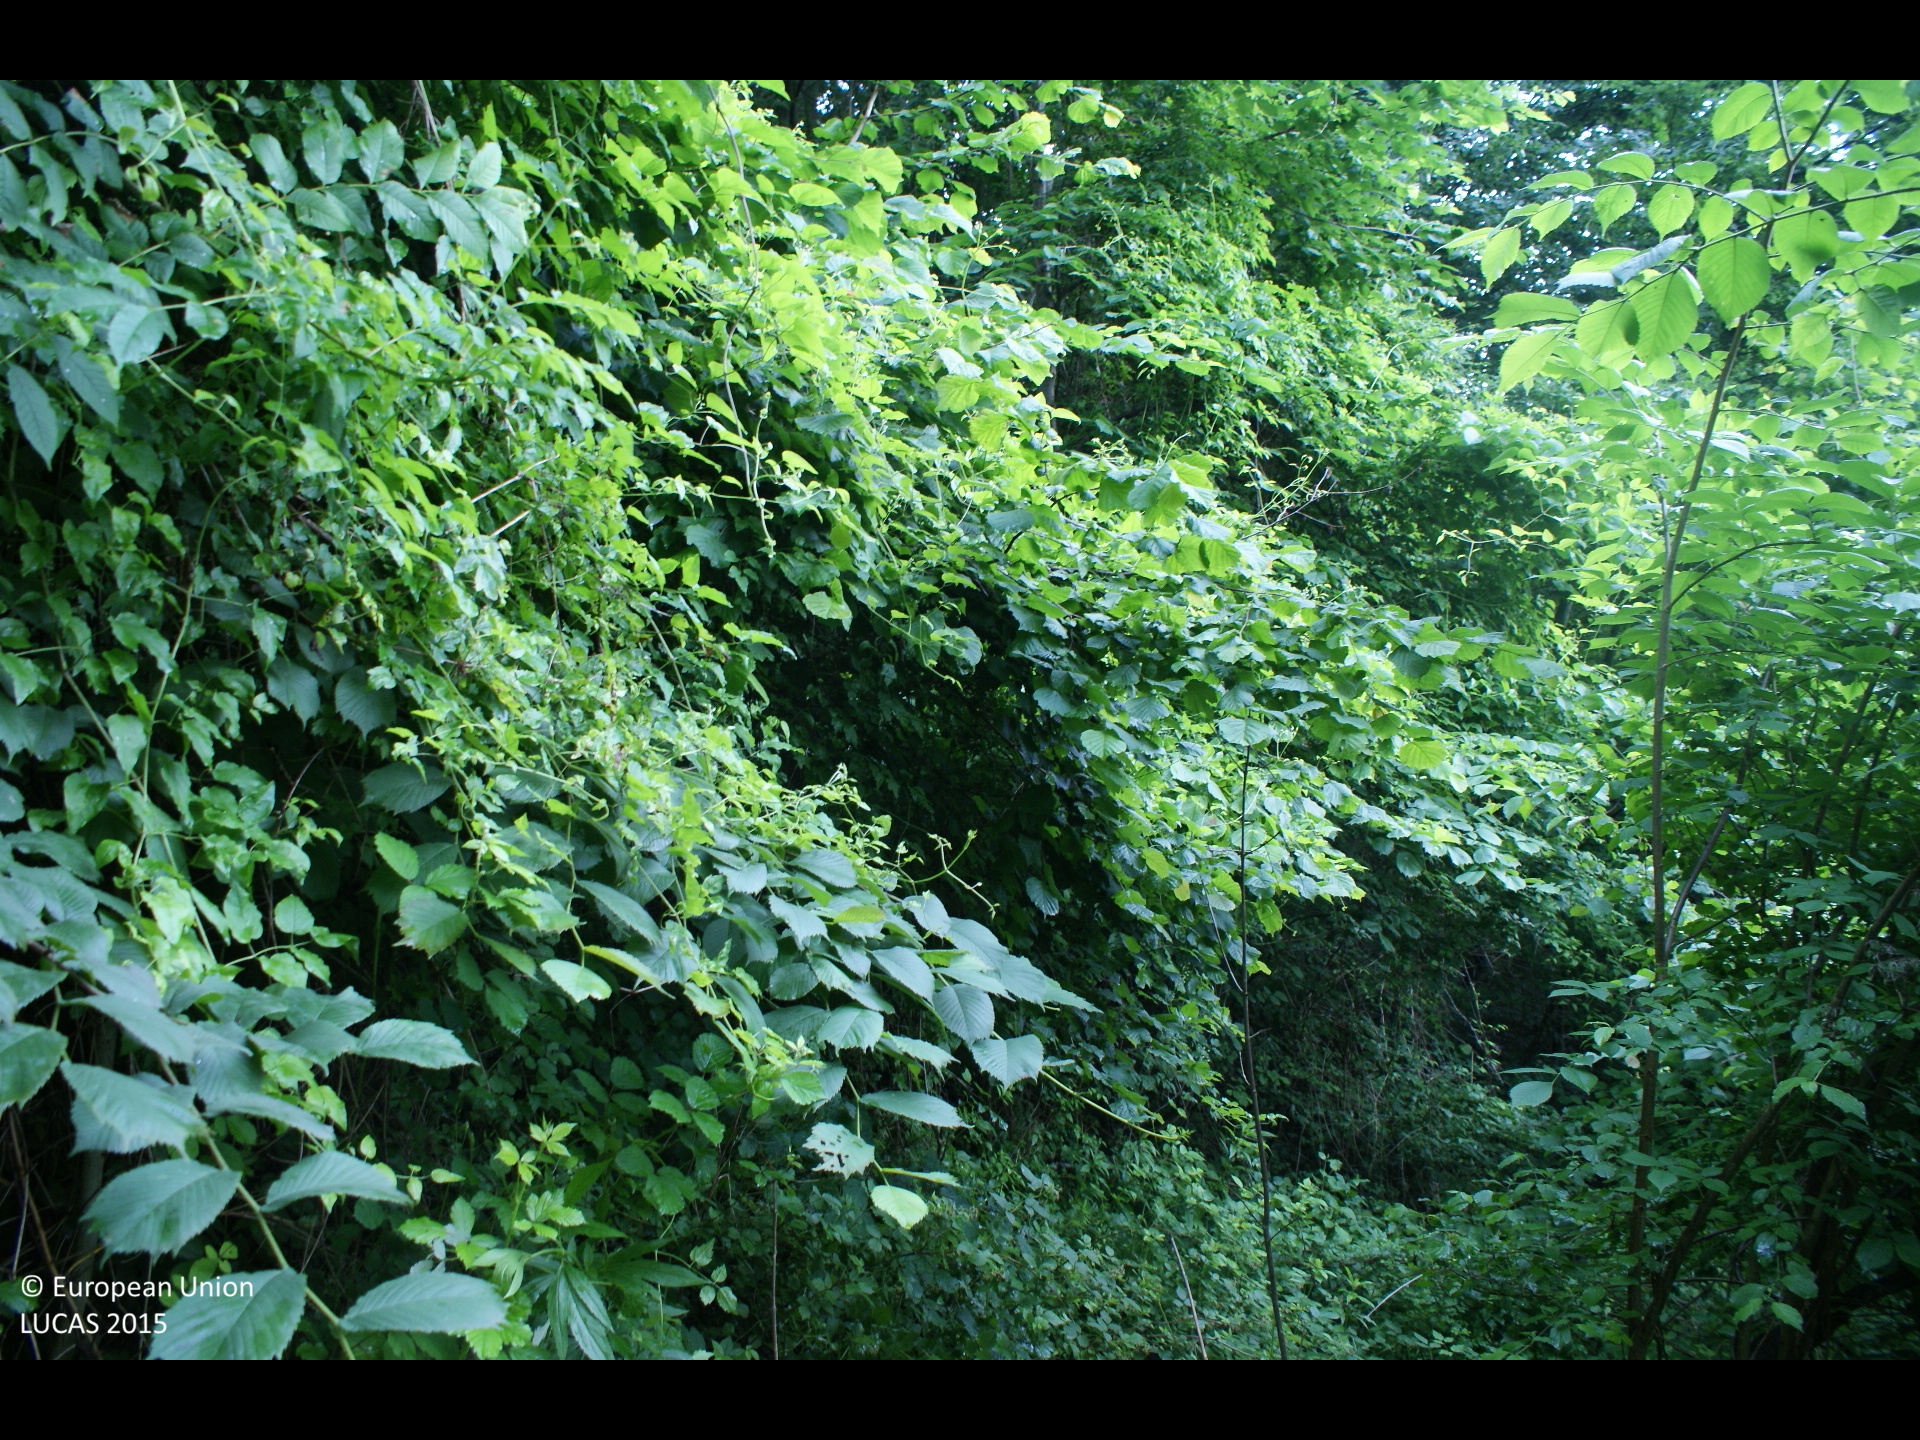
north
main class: Shrubland
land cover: Shrubland with sparse tree cover
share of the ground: > 75 %
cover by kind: shrubs 75 %, herbaceous plants 20 %, broadleaved forest trees 5 %
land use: Forestry
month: June
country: AT
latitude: 47.9553
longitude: 14.4055
